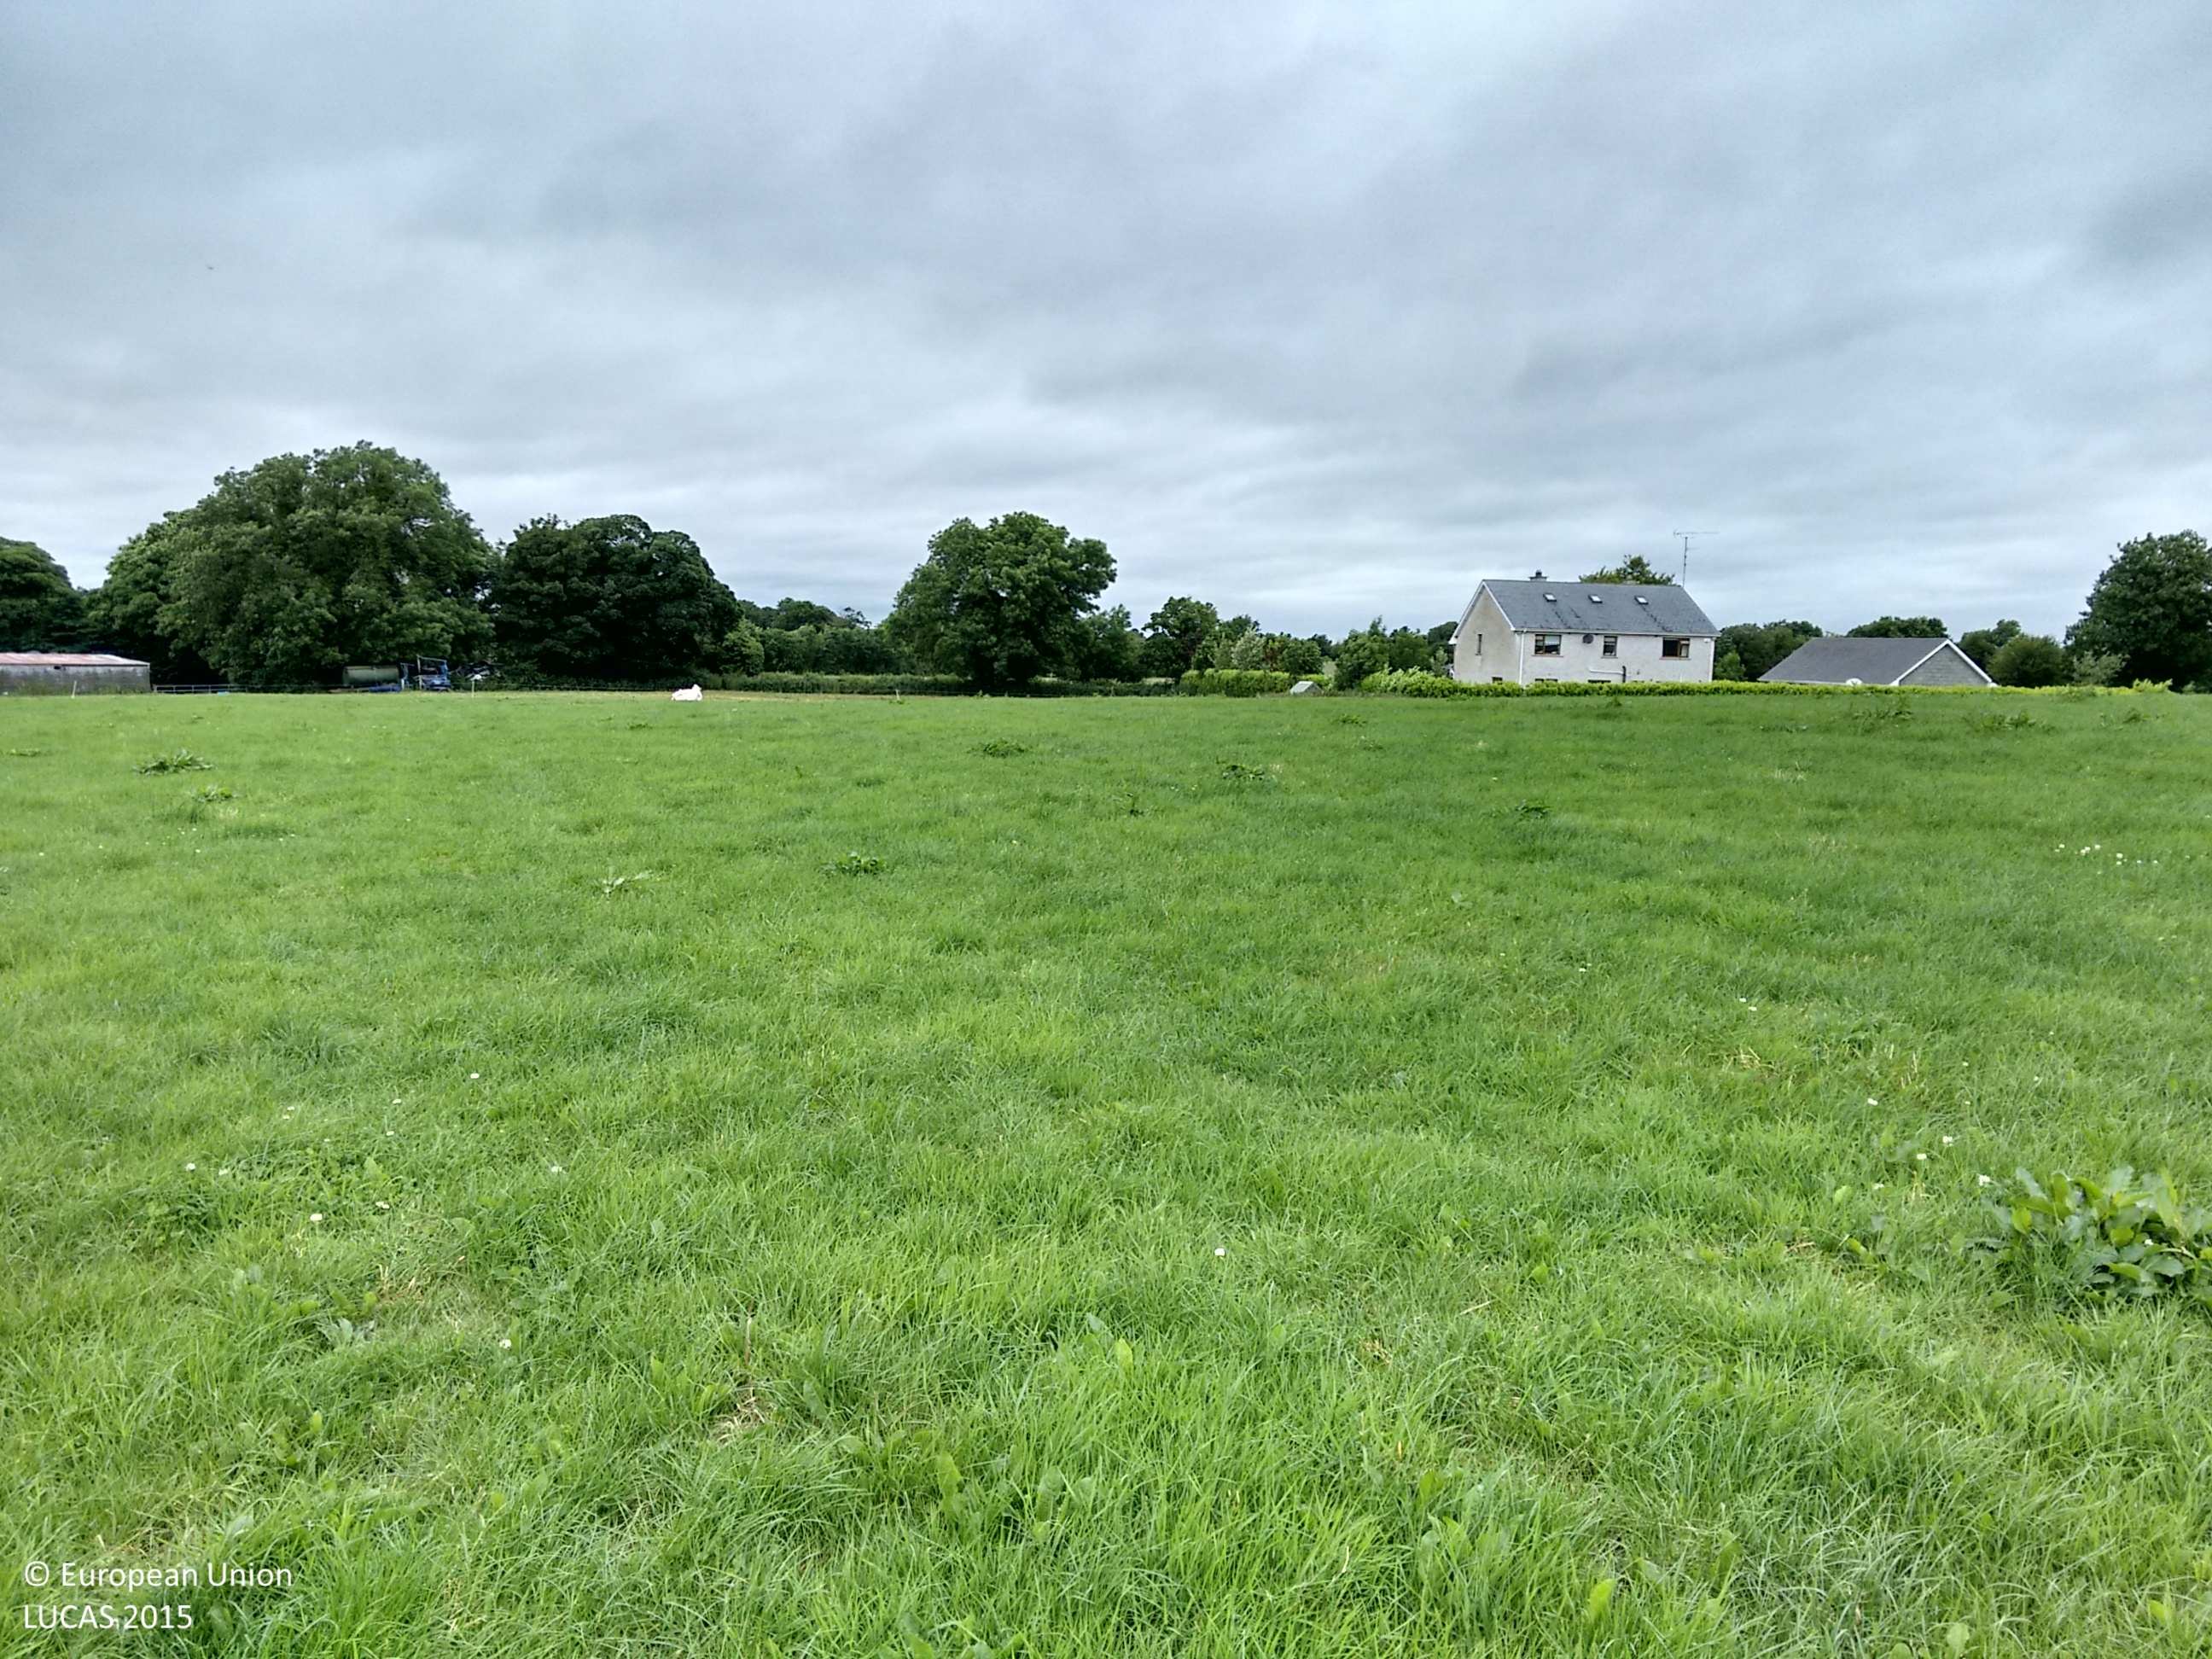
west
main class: Grassland
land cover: Grassland without tree/shrub cover
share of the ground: > 75 %
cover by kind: herbaceous plants 100 %
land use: Agriculture (excluding fallow land and kitchen gardens)
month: July
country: IE
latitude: 53.5138
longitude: -6.9861
